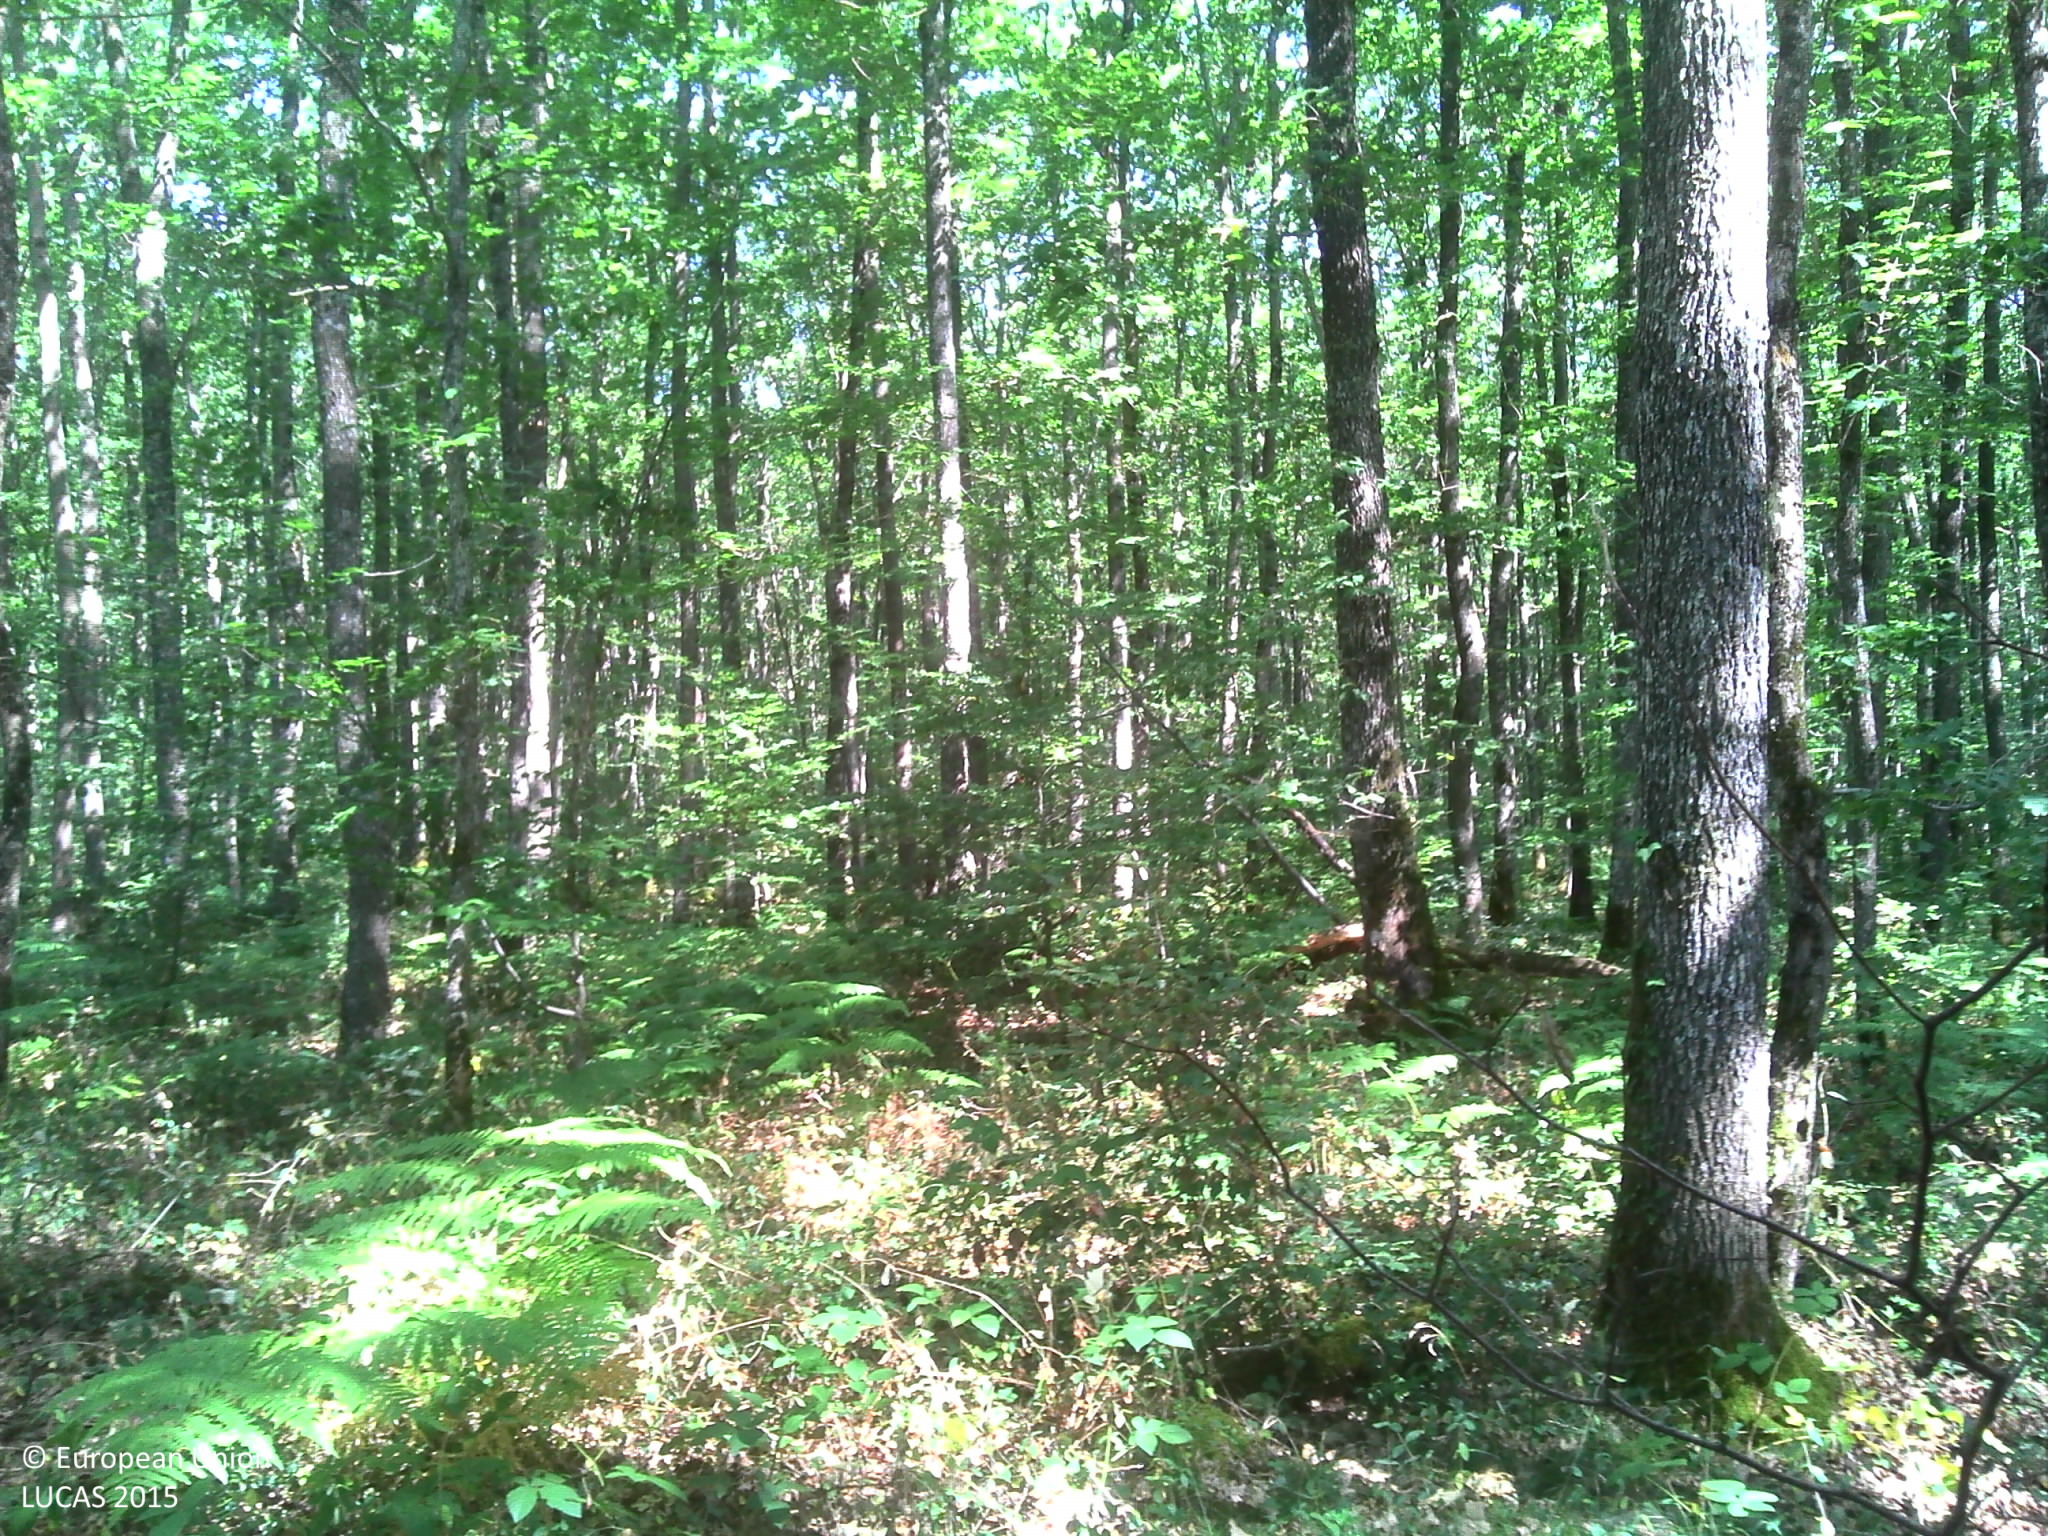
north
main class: Woodland
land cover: Broadleaved woodland
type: mesophytic deciduous forest
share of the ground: > 75 %
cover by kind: broadleaved forest trees 95 %, herbaceous plants 5 %
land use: Forestry
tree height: > 5 m
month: July
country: FR
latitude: 46.4303
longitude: 2.7477
